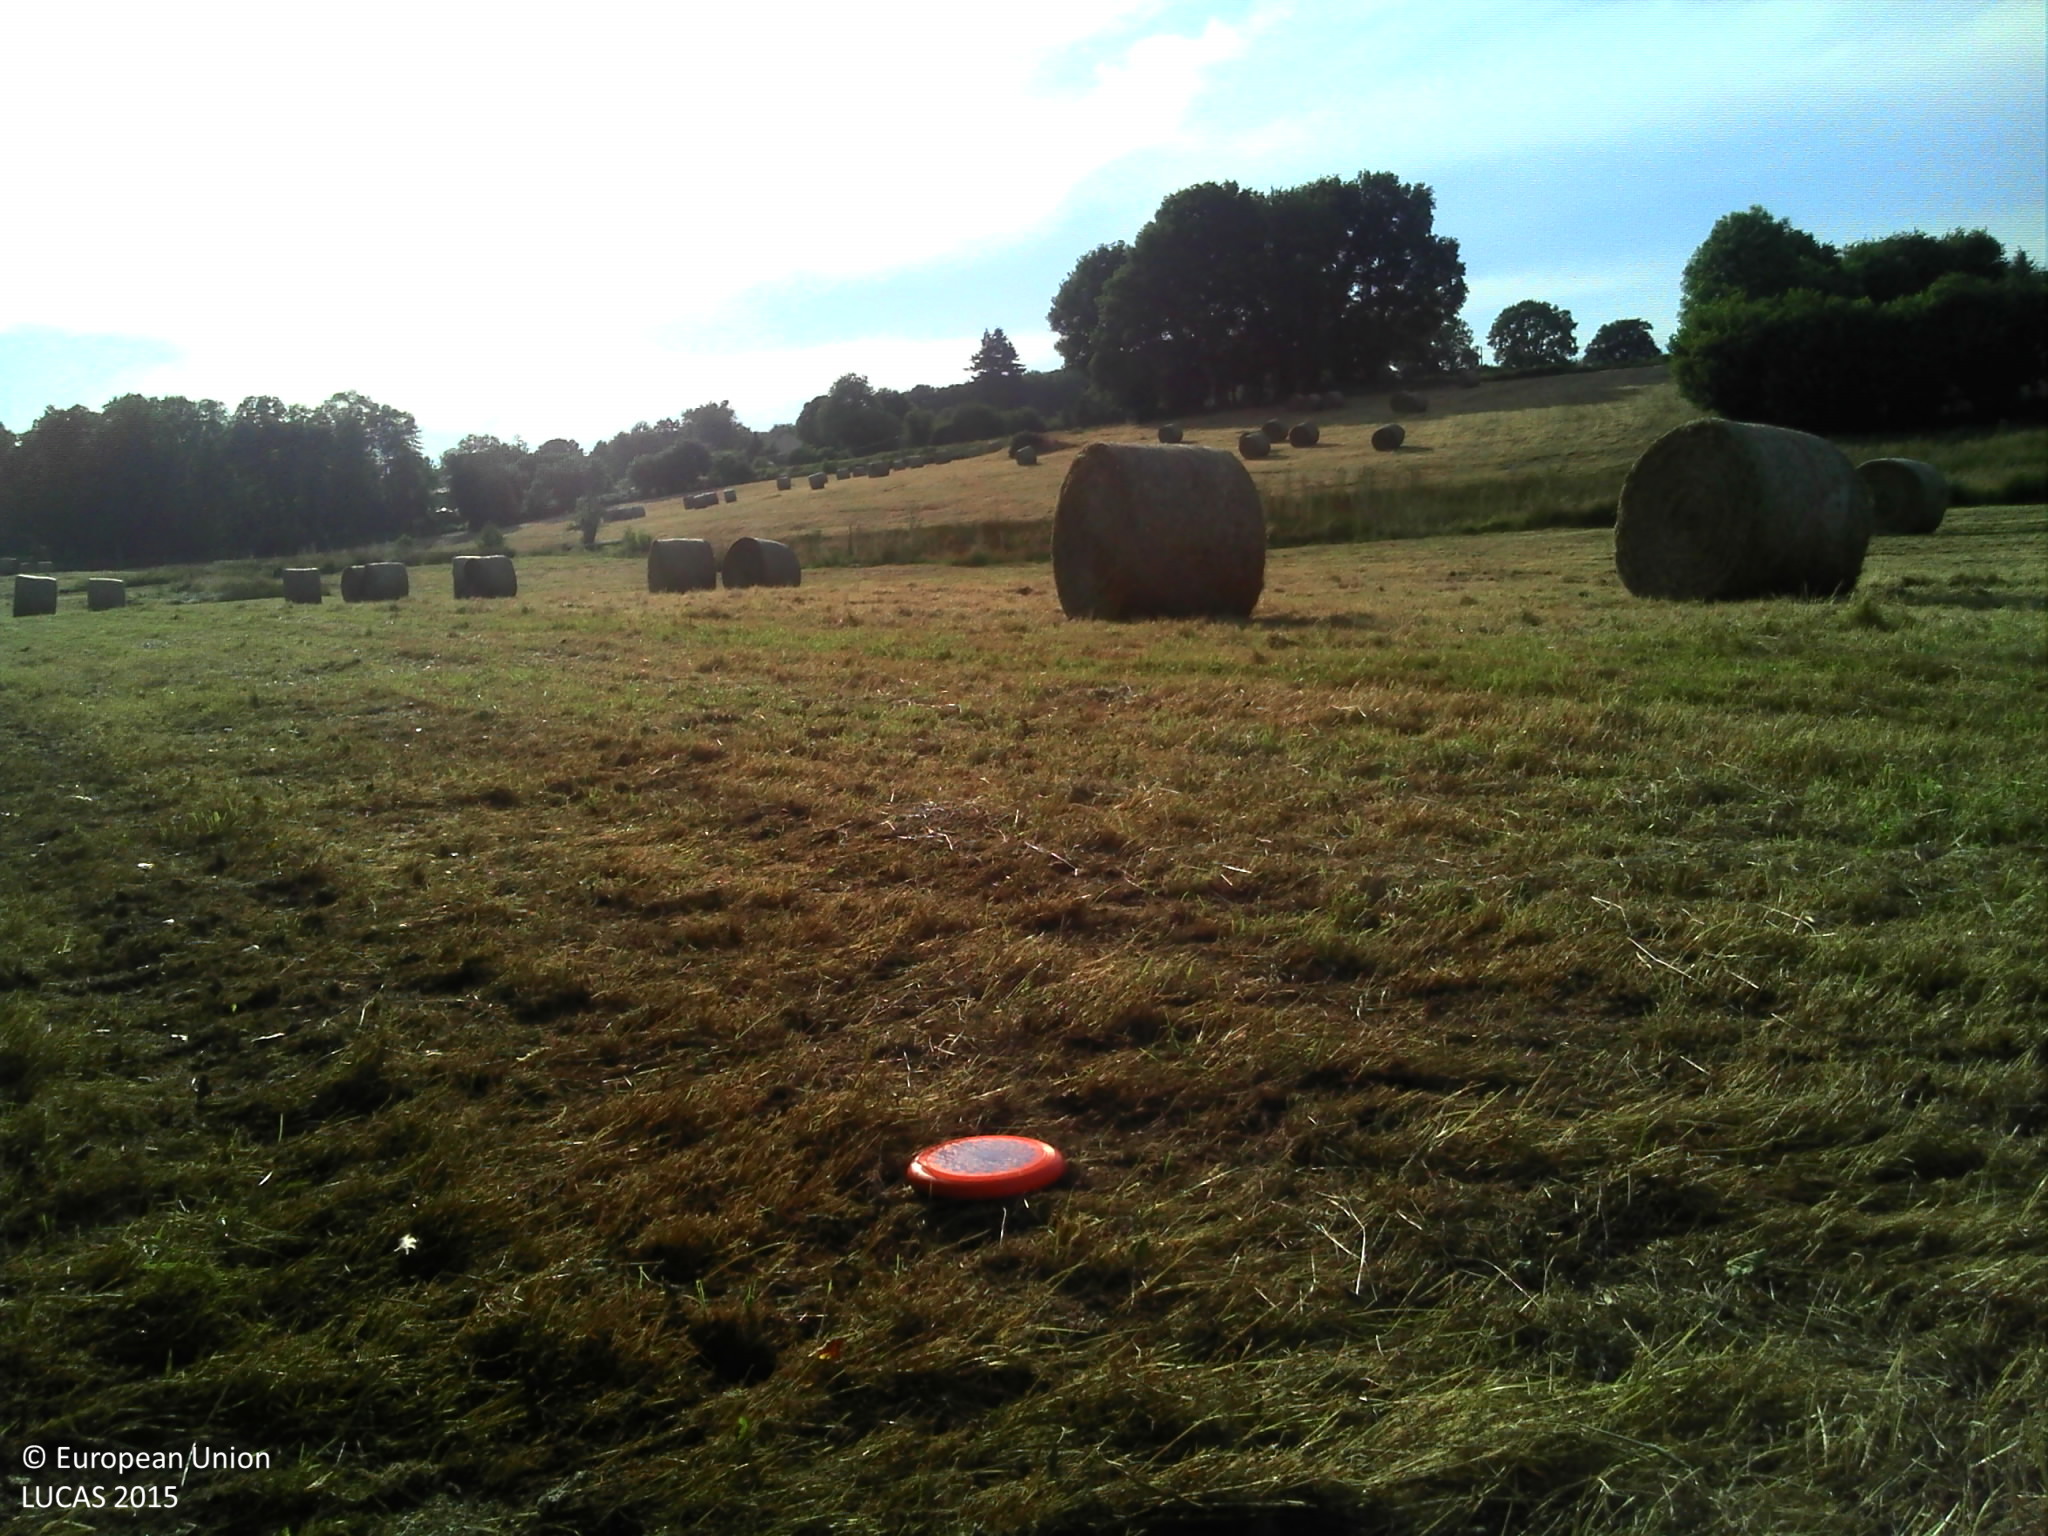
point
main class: Grassland
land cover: Grassland without tree/shrub cover
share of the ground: > 75 %
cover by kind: herbaceous plants 100 %
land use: Agriculture (excluding fallow land and kitchen gardens)
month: June
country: FR
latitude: 48.5823
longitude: -0.2123
